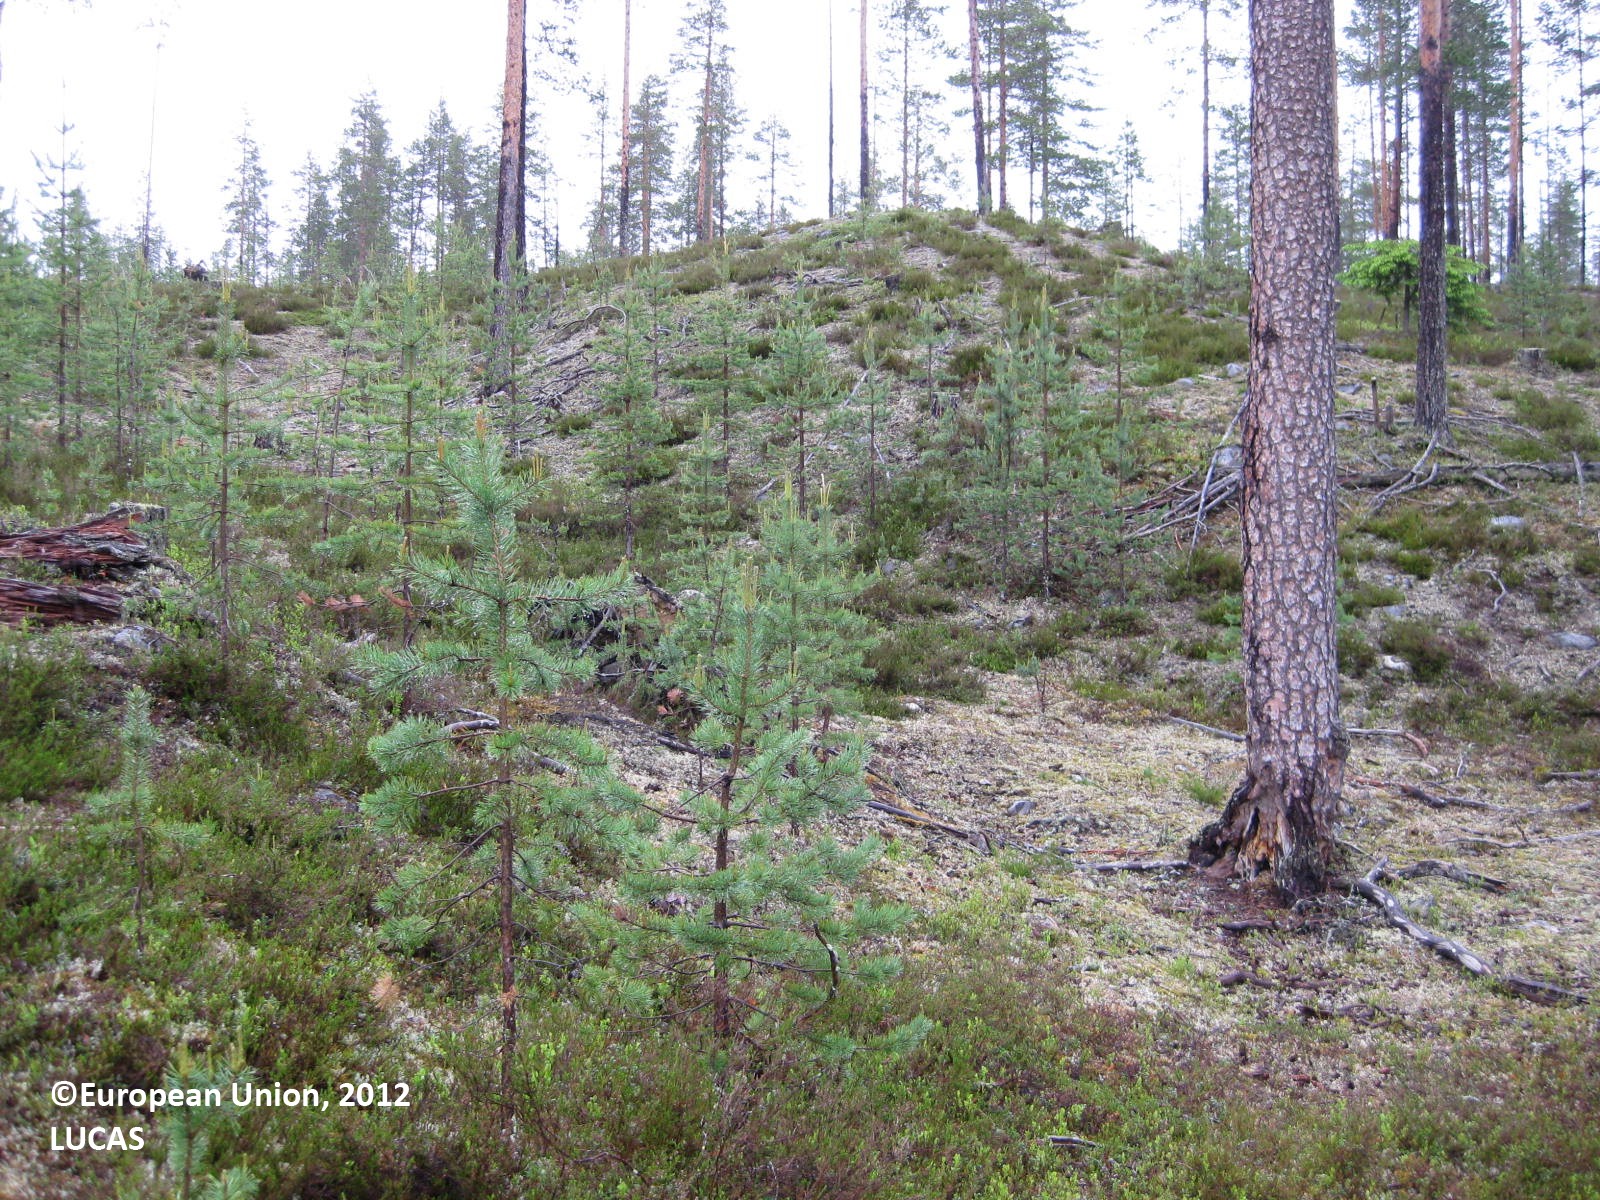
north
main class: Woodland
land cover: Pine dominated coniferous woodland
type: boreal forest
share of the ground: 50 - 75 %
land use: Forestry
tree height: > 5 m
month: June
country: FI
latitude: 65.4356
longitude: 29.6732
